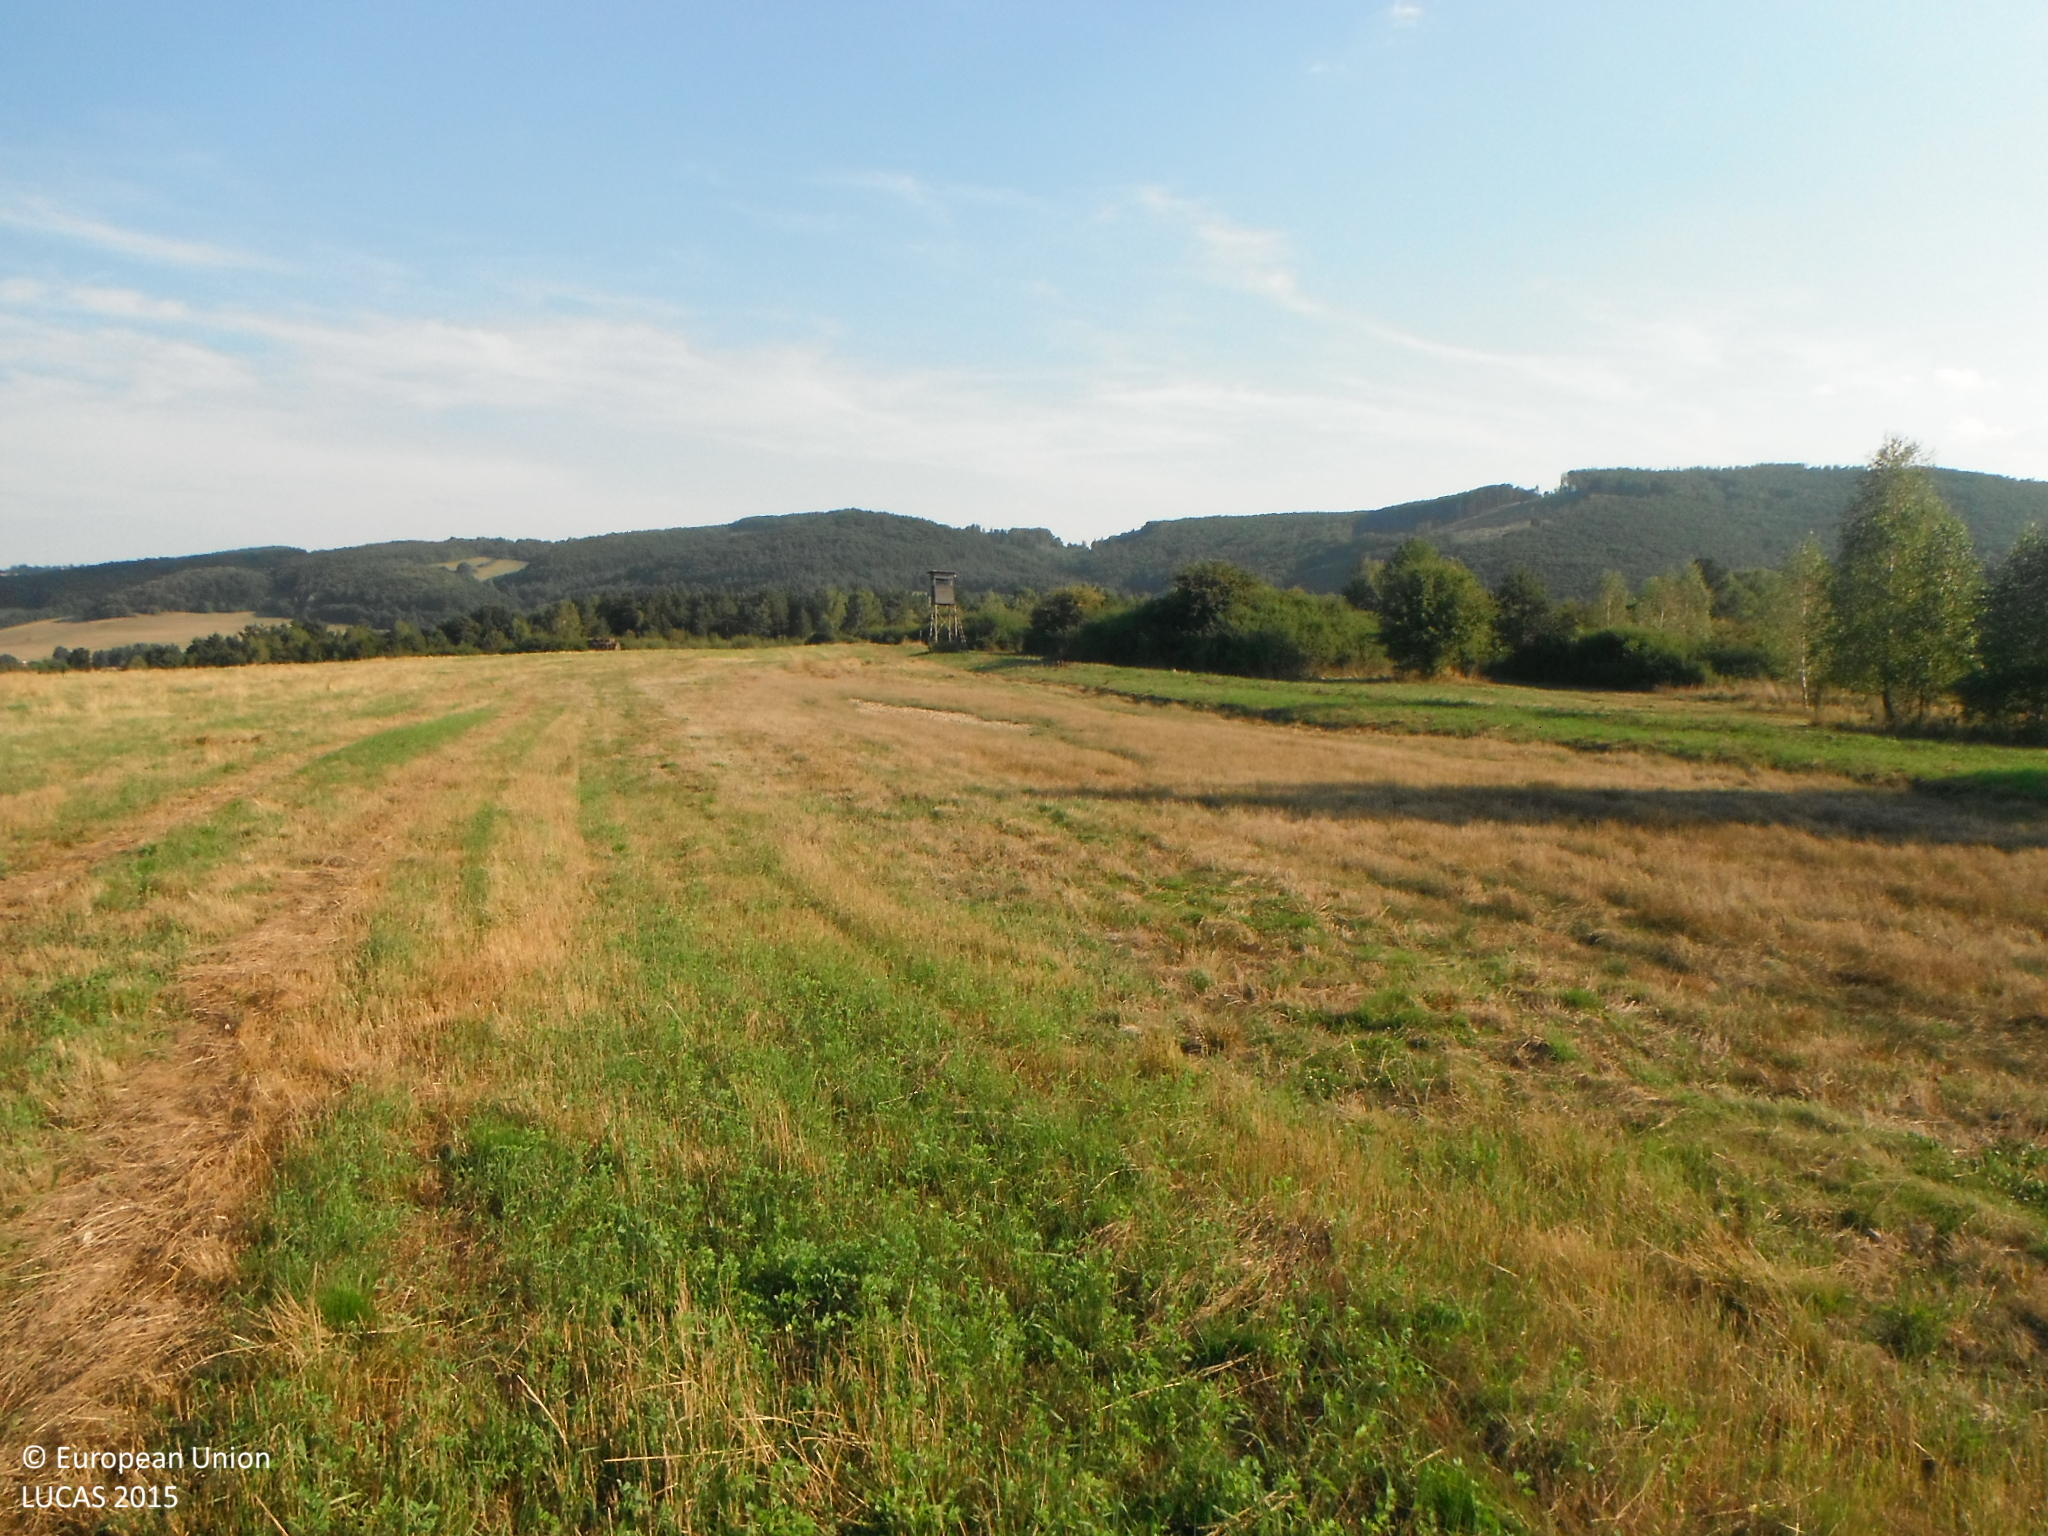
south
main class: Cropland
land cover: Other leguminous and mixtures for fodder
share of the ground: > 75 %
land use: Agriculture (excluding fallow land and kitchen gardens)
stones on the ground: < 10 %
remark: Harvested field
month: August
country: SK
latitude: 48.4246
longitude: 19.1160
